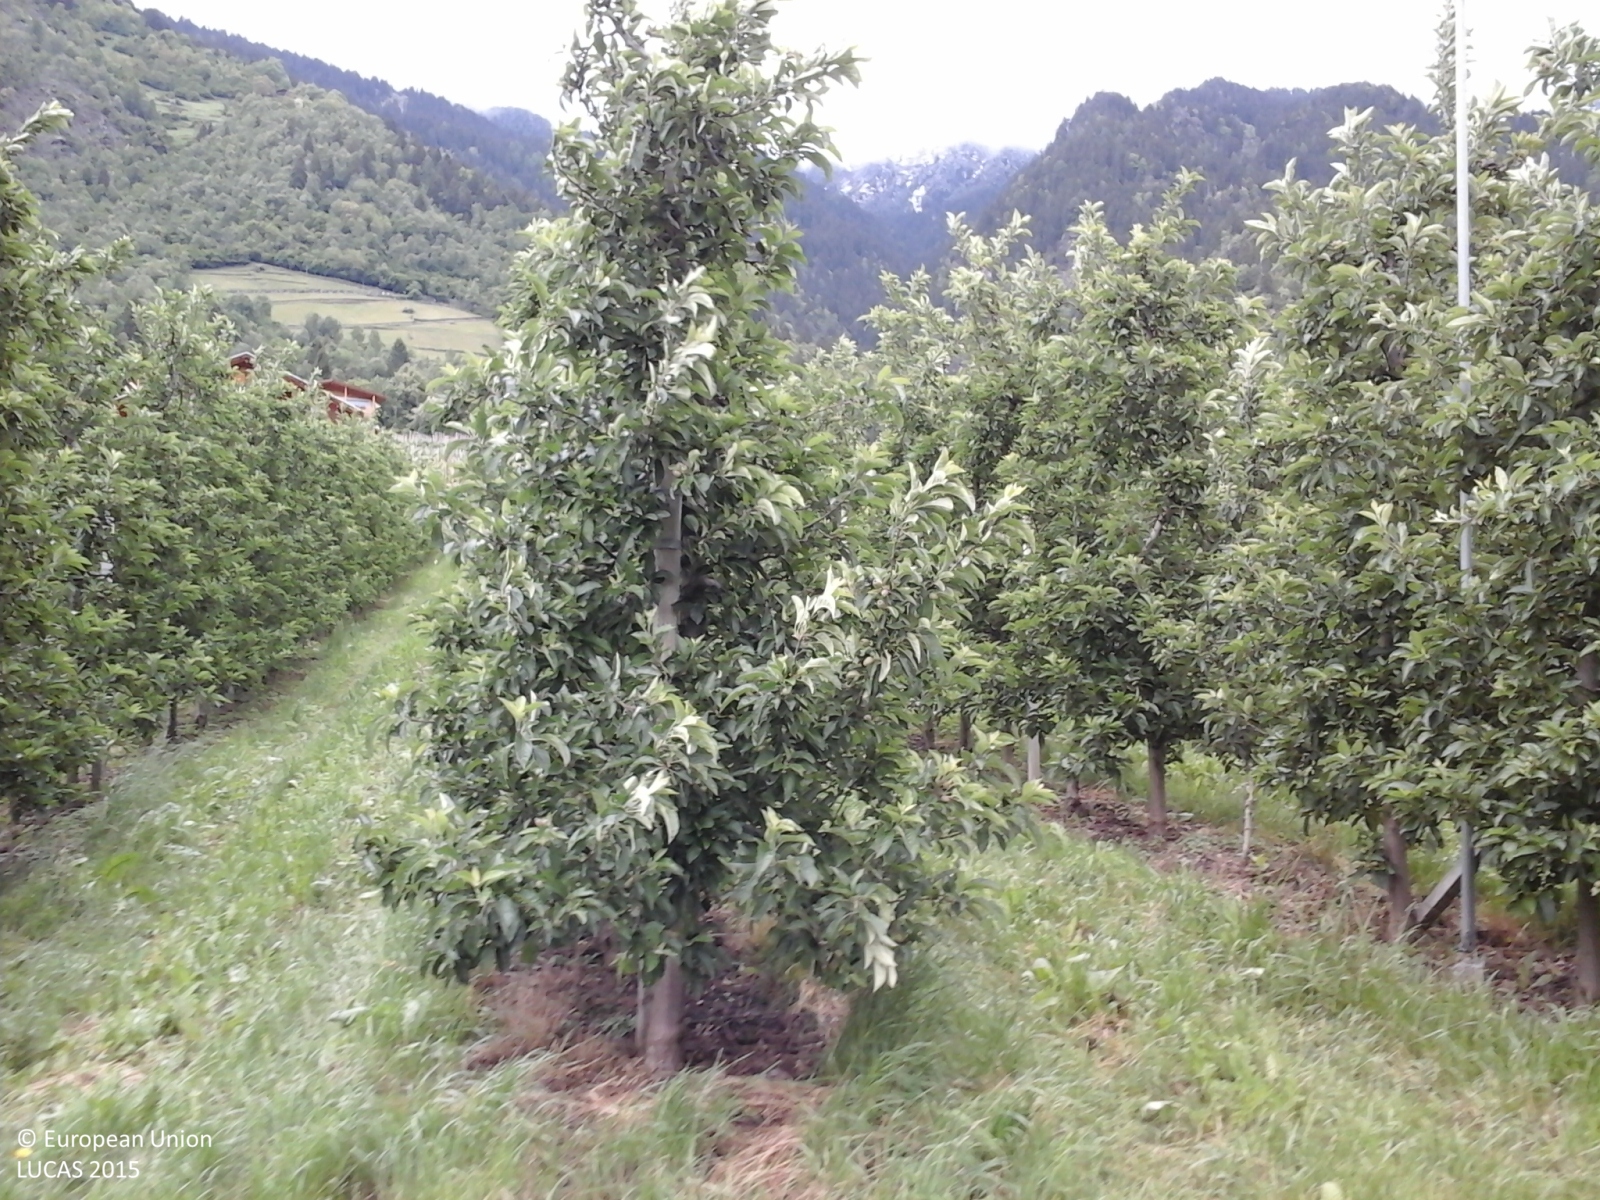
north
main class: Cropland
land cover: Apple fruit
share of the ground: > 75 %
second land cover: Grassland without tree/shrub cover
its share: > 75 %
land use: Agriculture (excluding fallow land and kitchen gardens)
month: May
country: IT
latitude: 46.6879
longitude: 11.0840
